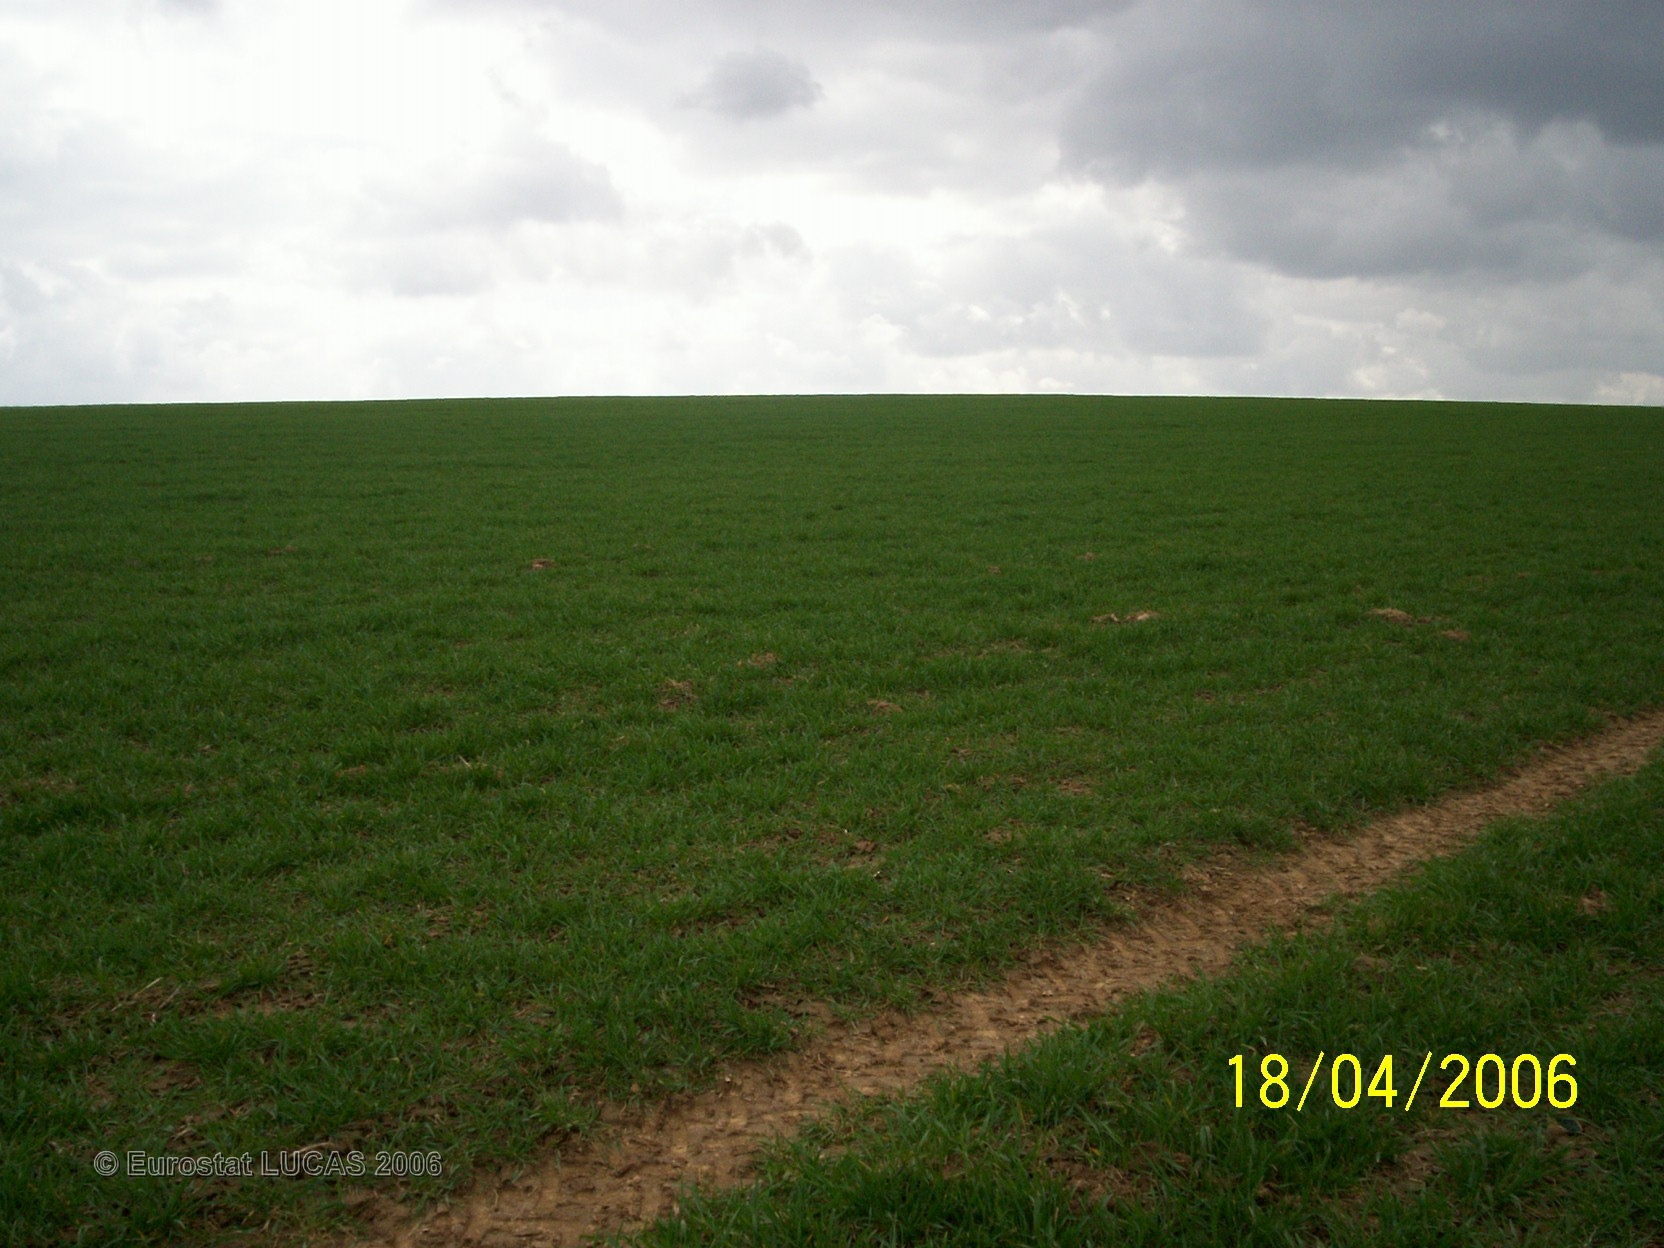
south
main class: Cropland
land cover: Common wheat
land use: Agriculture (excluding fallow land and kitchen gardens)
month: April
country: FR
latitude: 50.3380
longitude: 2.5552
